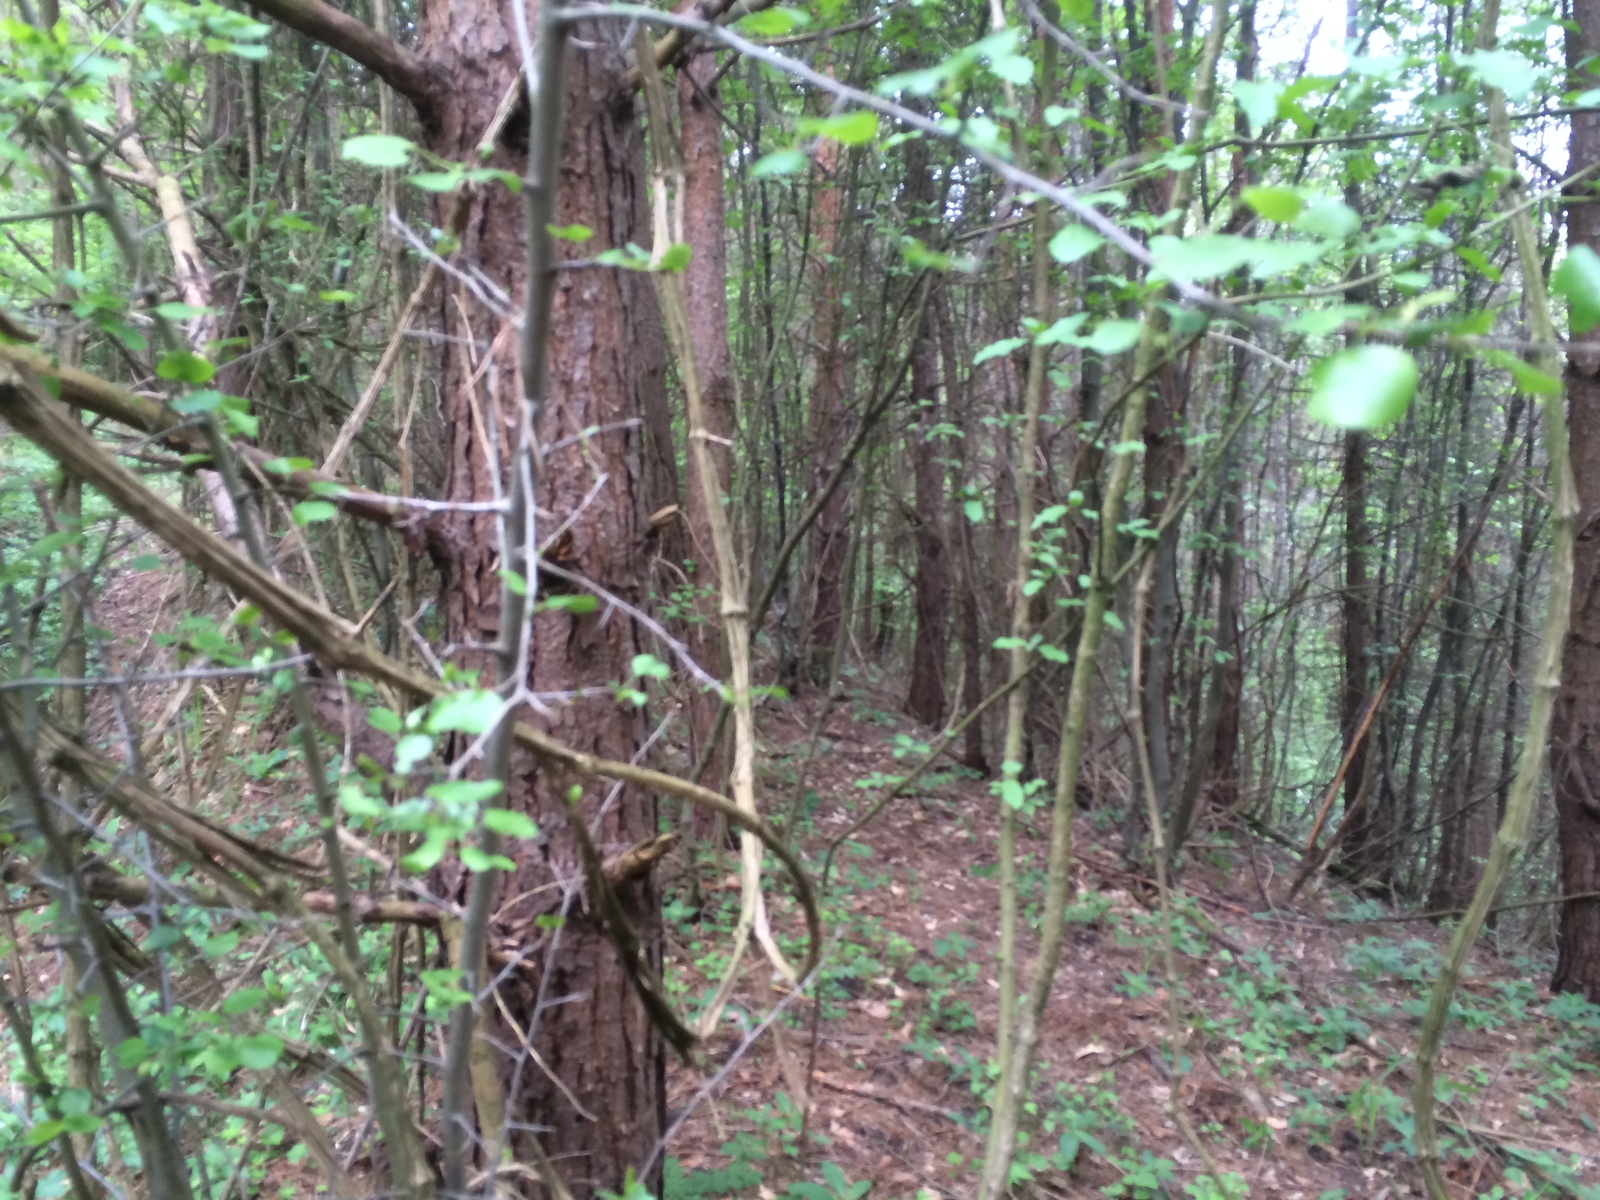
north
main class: Woodland
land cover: Pine dominated mixed woodland
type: mountainous beech forest
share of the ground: > 75 %
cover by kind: broadleaved forest trees 60 %, coniferous forest trees 40 %
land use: Forestry
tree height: > 5 m
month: May
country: AT
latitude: 48.0721
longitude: 16.1105
